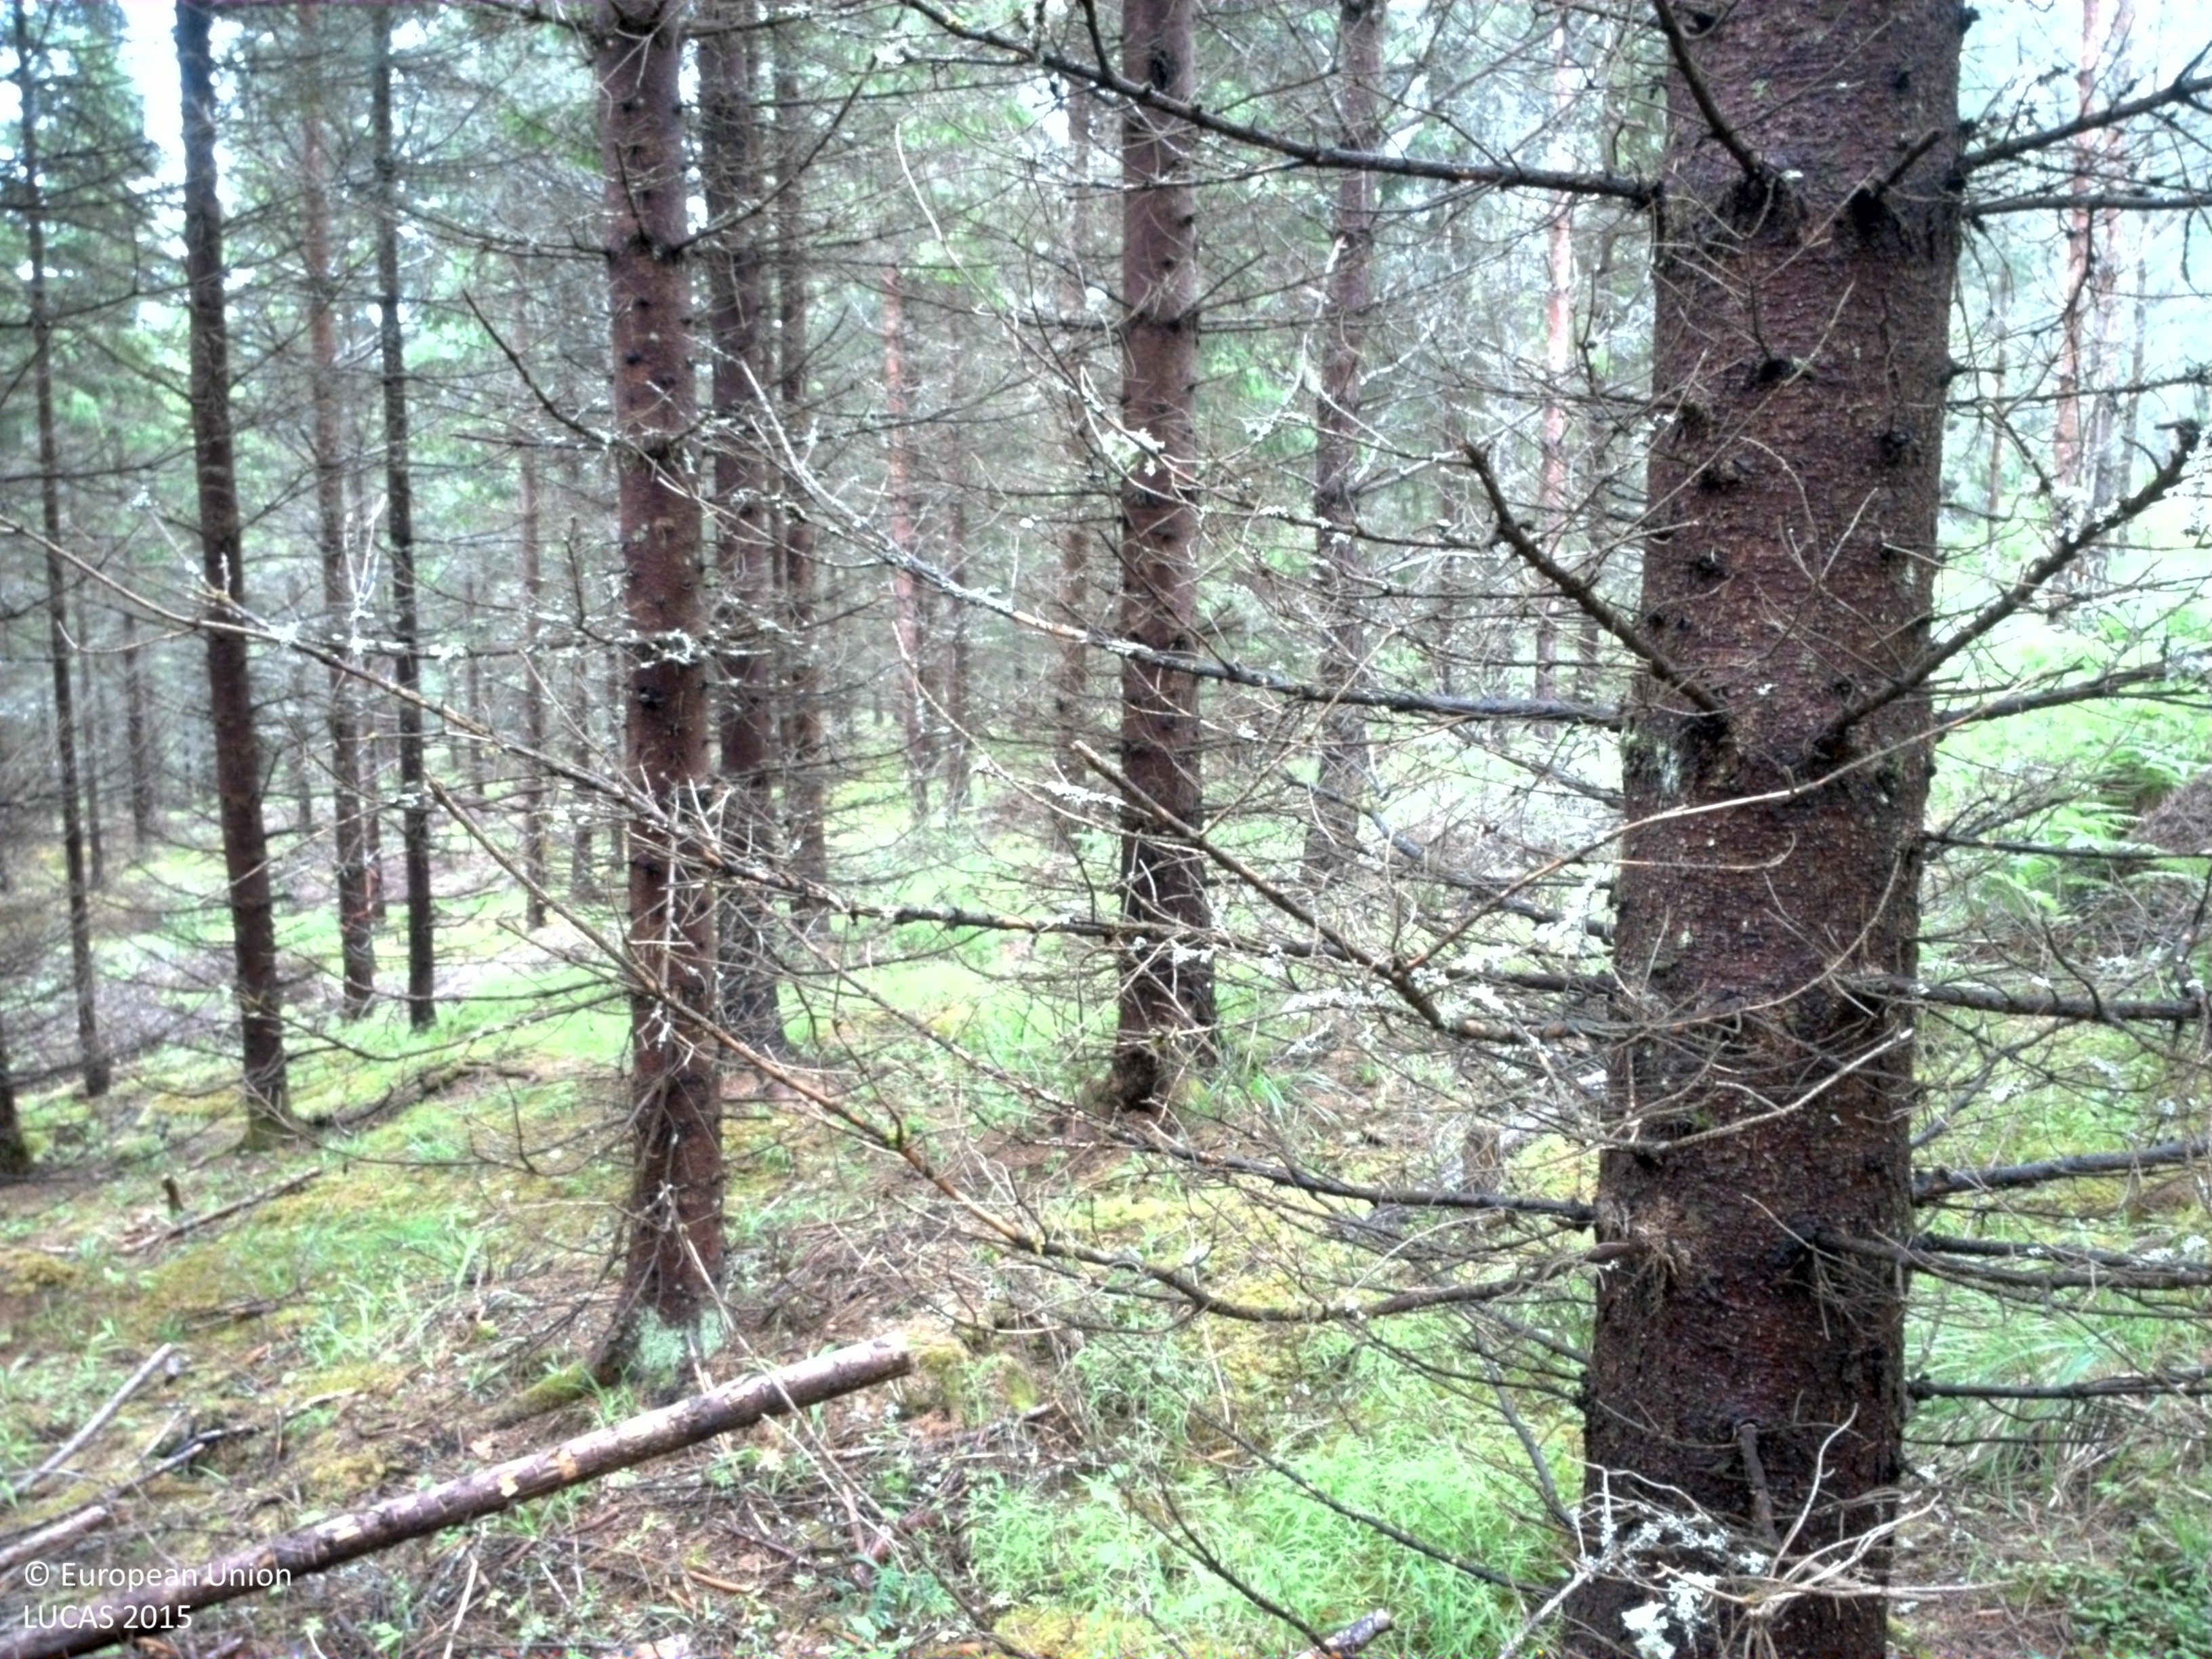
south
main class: Woodland
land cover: Spruce dominated coniferous woodland
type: boreal forest
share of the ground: 50 - 75 %
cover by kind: coniferous forest trees 65 %, lichens and mosses 30 %, herbaceous plants 5 %
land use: Forestry
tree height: > 5 m
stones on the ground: 25 - 50 %
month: July
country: SE
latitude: 59.2420
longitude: 12.3959
